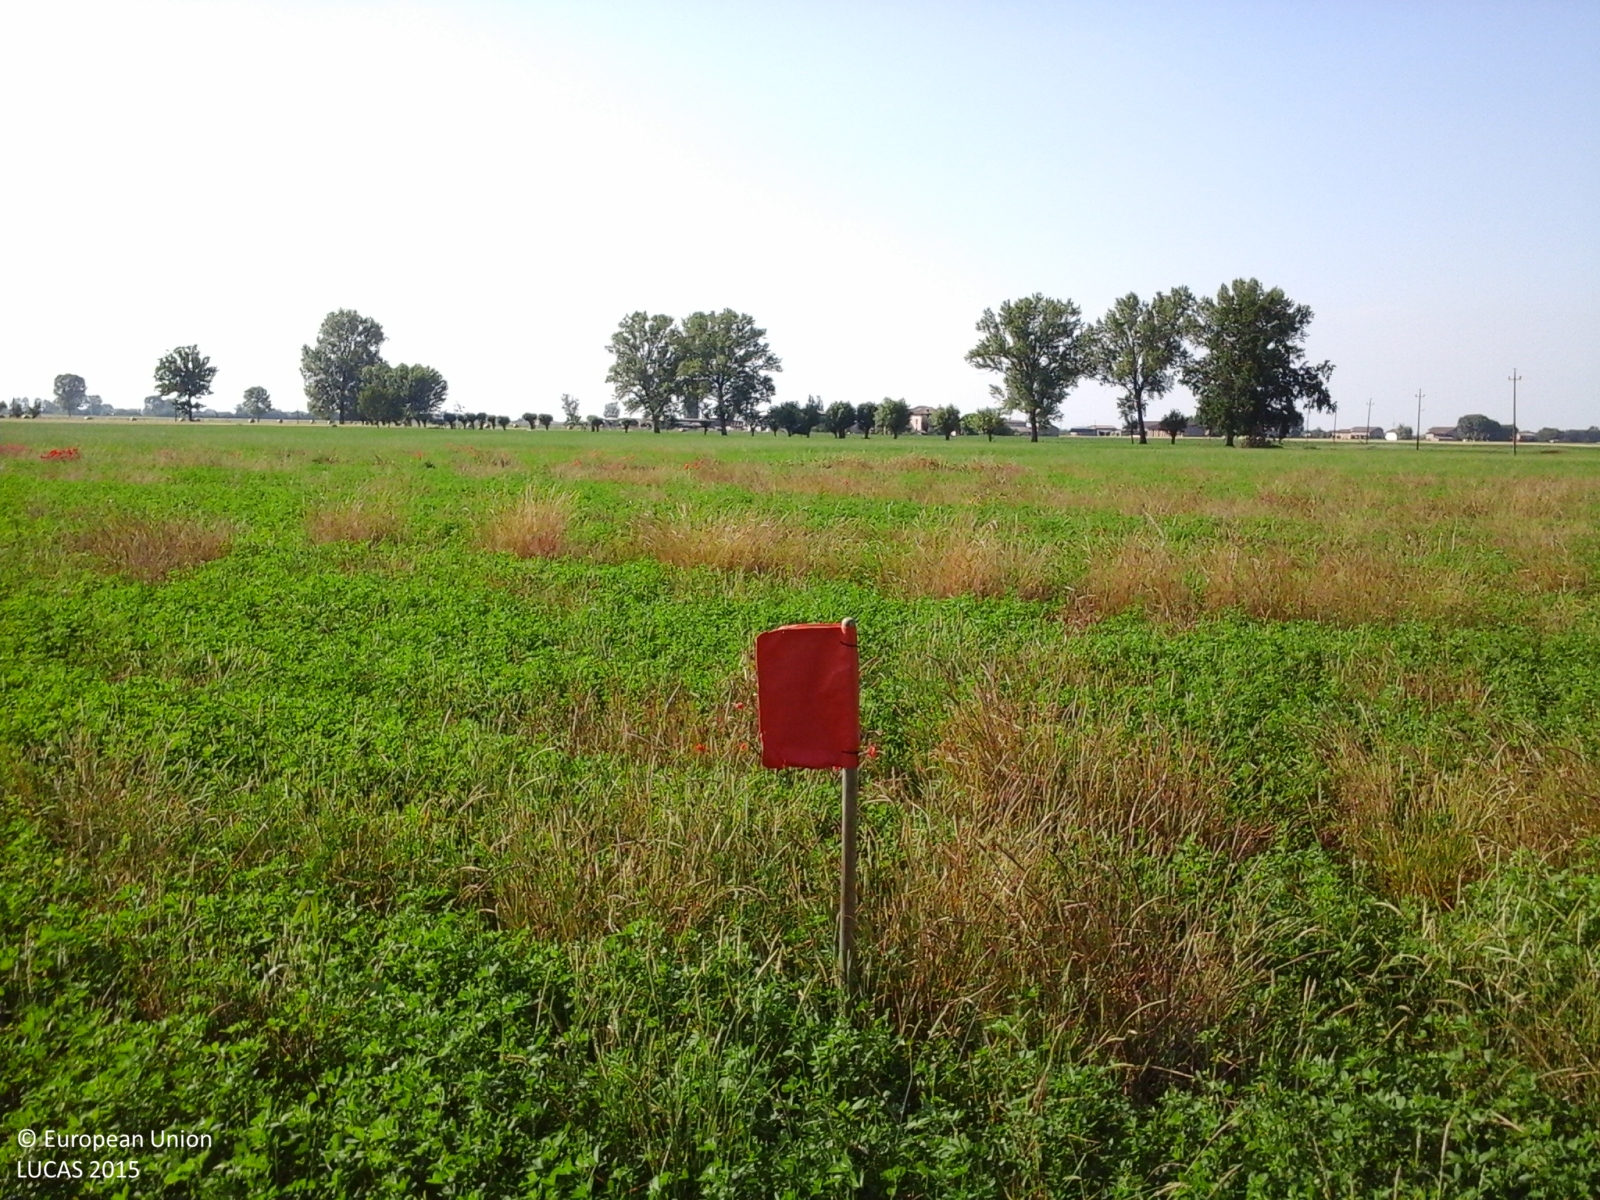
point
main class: Cropland
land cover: Lucerne
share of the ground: > 75 %
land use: Agriculture (excluding fallow land and kitchen gardens)
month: June
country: IT
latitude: 44.9094
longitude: 10.1643
